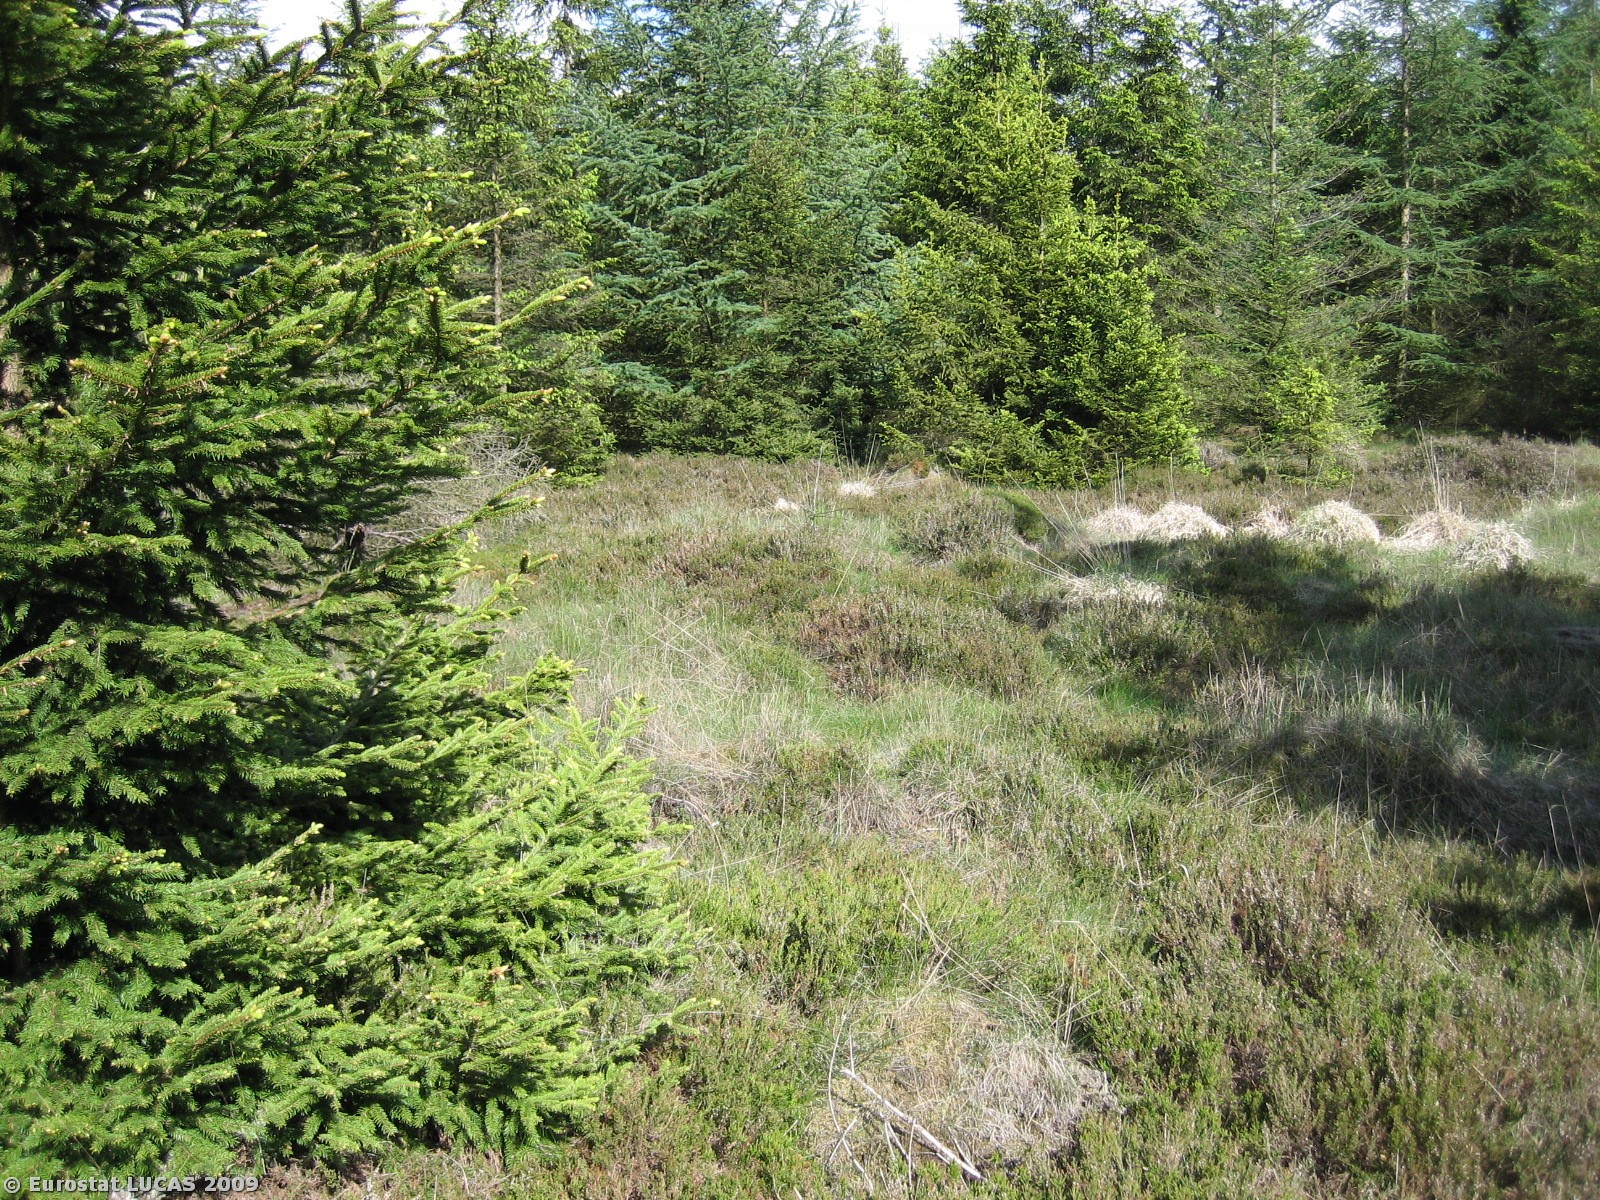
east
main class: Shrubland
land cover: Shrubland with sparse tree cover
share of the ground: > 75 %
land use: Forestry
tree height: > 5 m
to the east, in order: Shrubland with sparse tree cover; Coniferous woodland; Shrubland with sparse tree cover; Coniferous woodland; Shrubland with sparse tree cover; Tracks; Shrubland with sparse tree cover; Coniferous woodland; Shrubland with sparse tree cover; Coniferous woodland; Shrubland with sparse tree cover
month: May
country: DK
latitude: 56.0574
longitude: 8.9253
